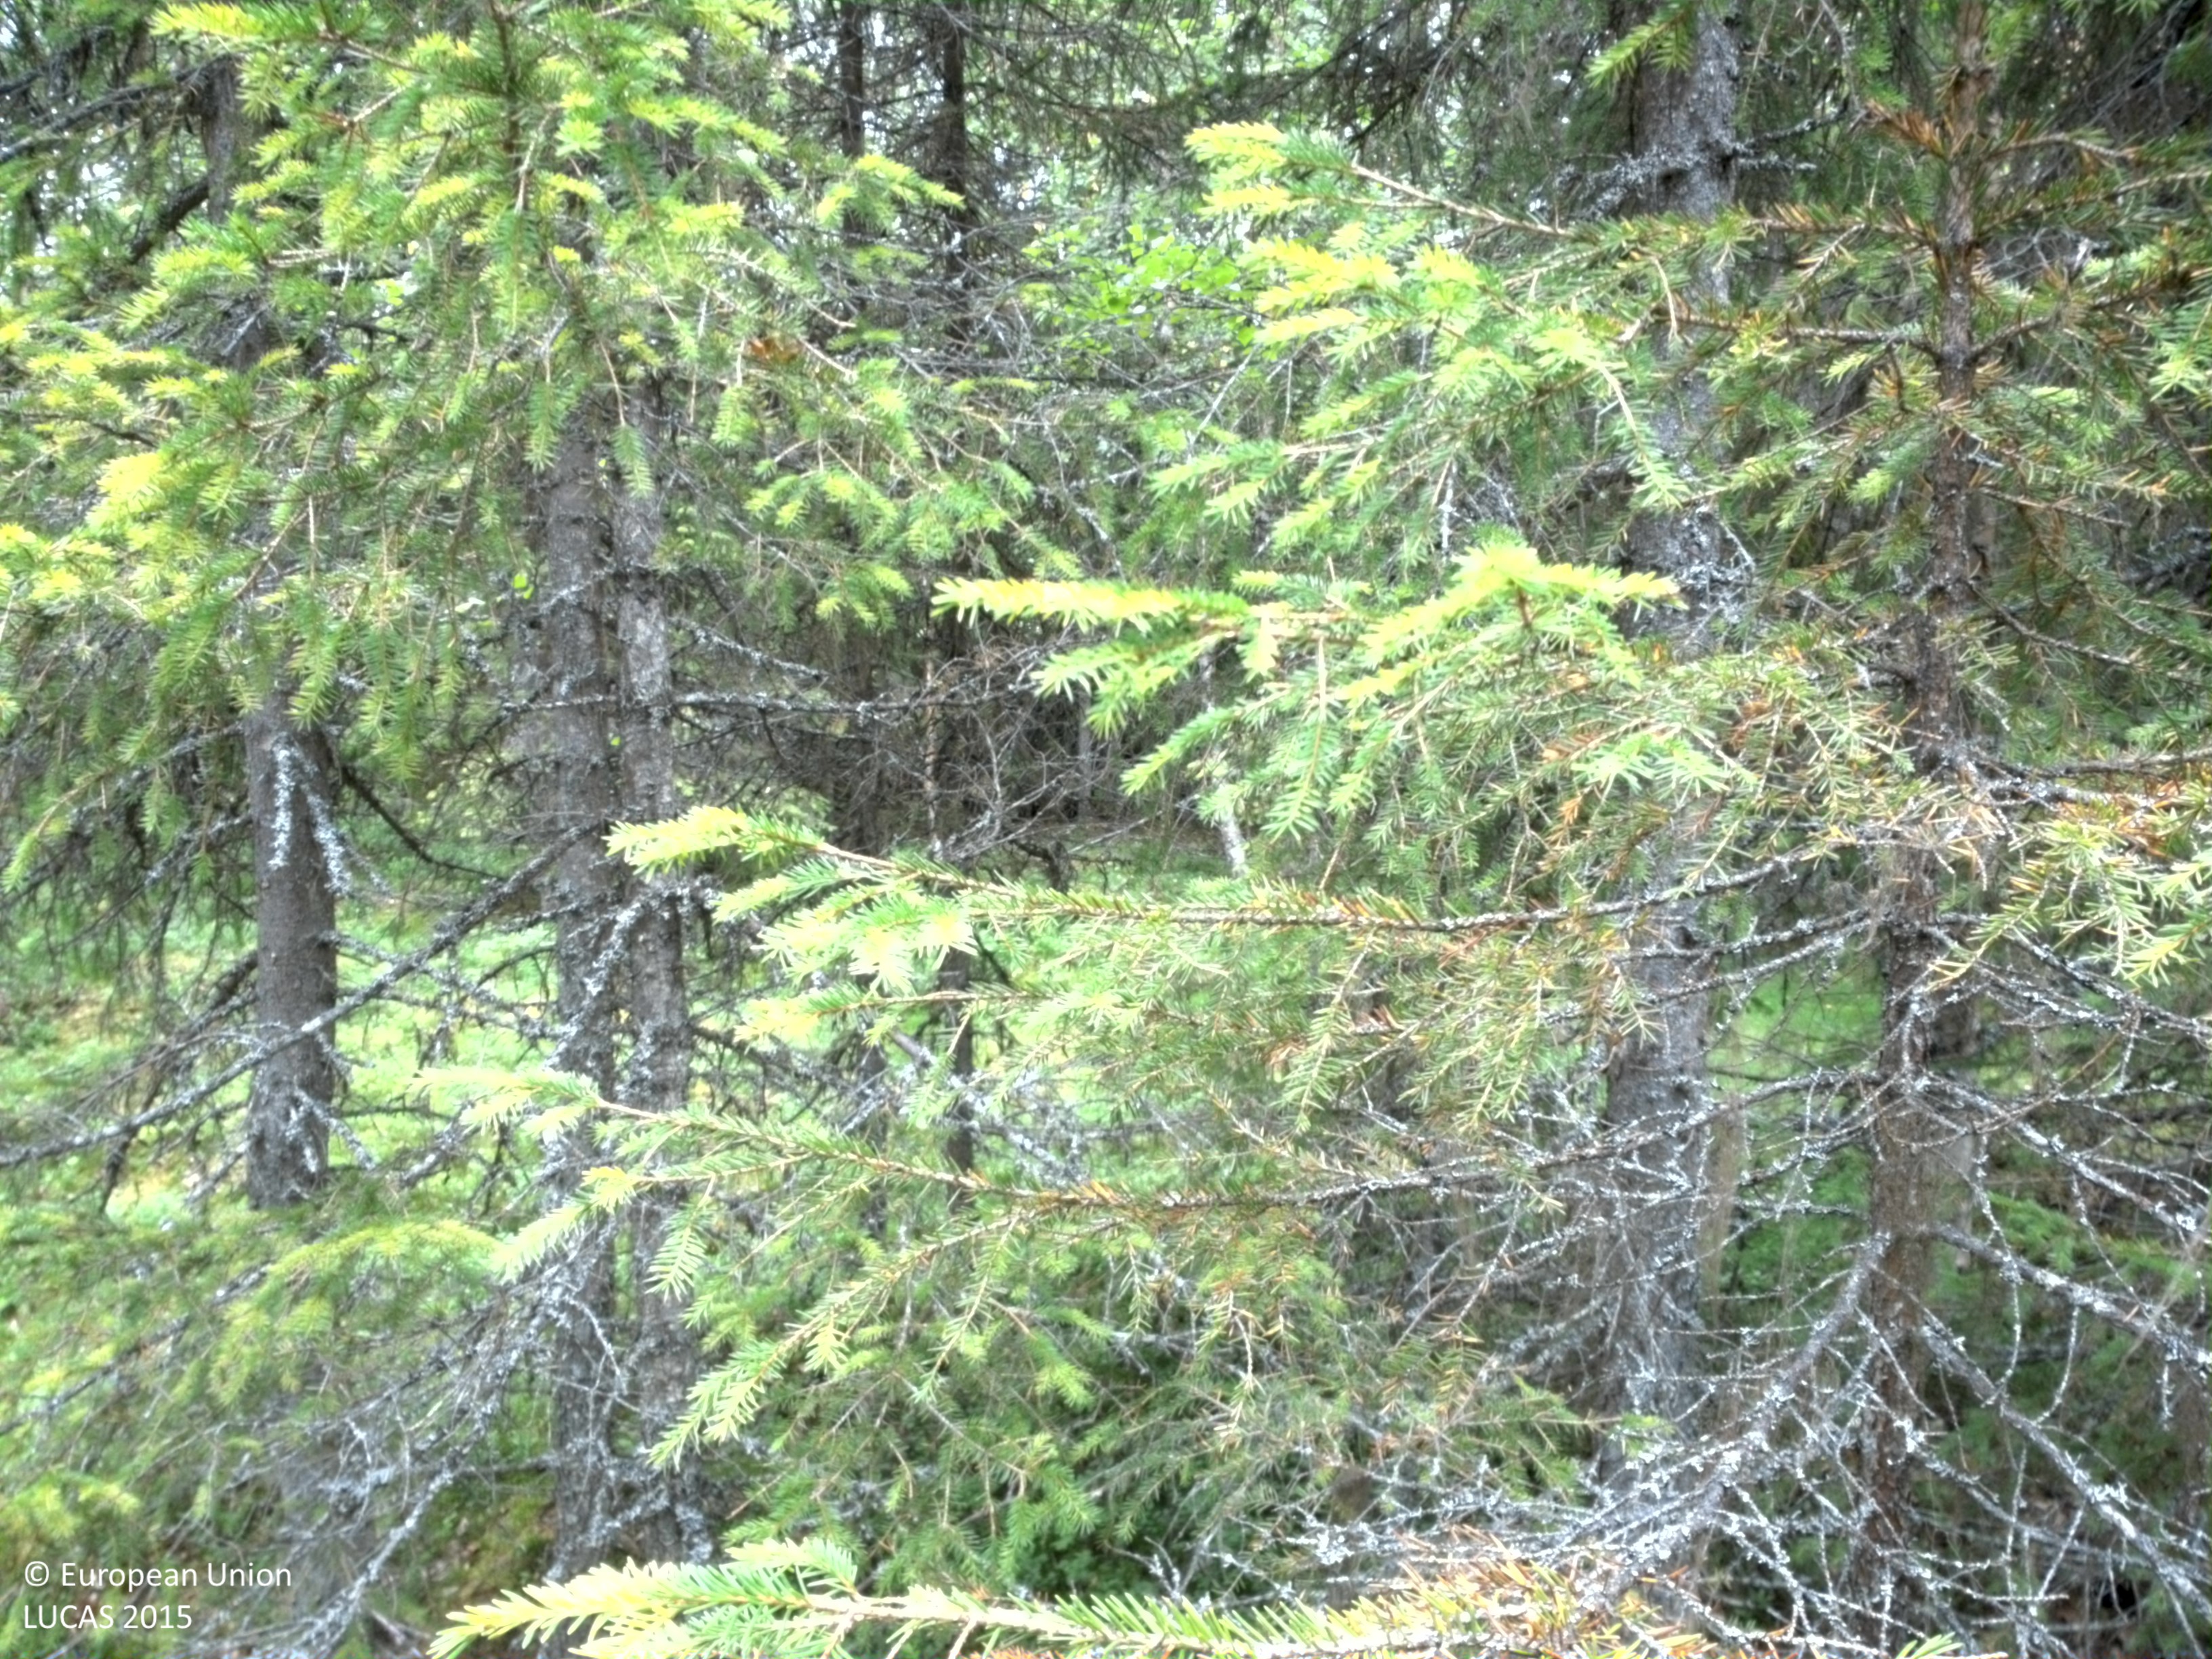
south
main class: Woodland
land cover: Spruce dominated mixed woodland
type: boreal forest
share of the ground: 50 - 75 %
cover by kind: shrubs 30 %, coniferous forest trees 25 %, broadleaved forest trees 25 %, lichens and mosses 20 %
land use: Forestry
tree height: > 5 m
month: September
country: SE
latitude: 65.3671
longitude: 16.1344
